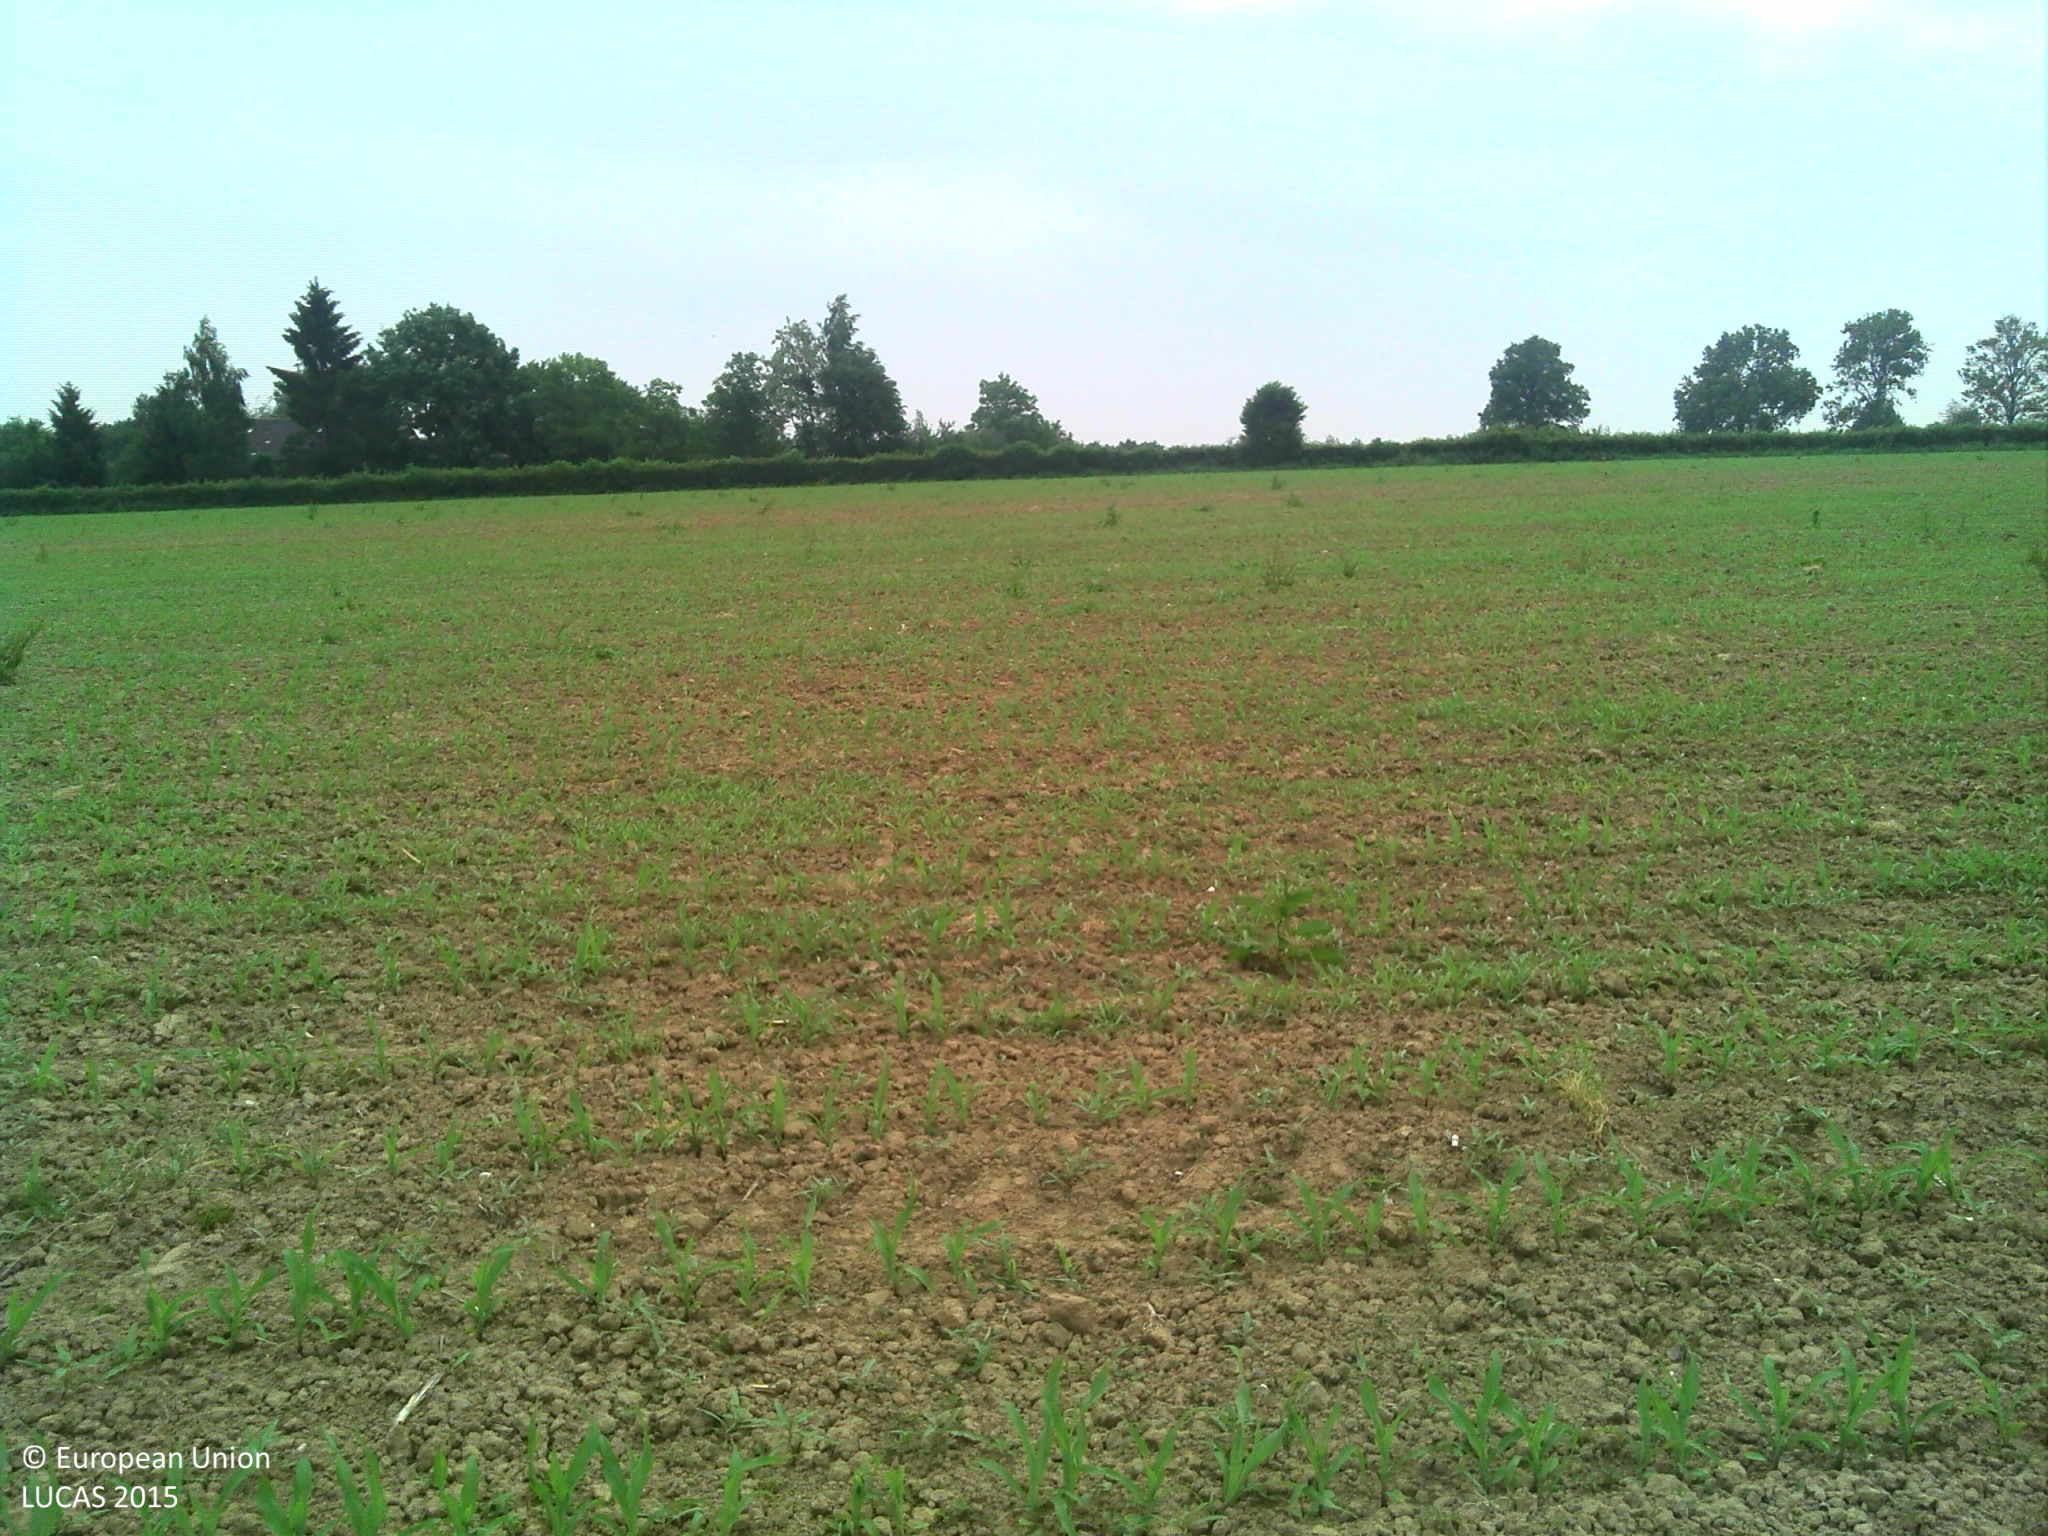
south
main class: Cropland
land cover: Maize
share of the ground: 10 - 25 %
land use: Agriculture (excluding fallow land and kitchen gardens)
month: June
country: FR
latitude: 49.9534
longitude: 3.9873
